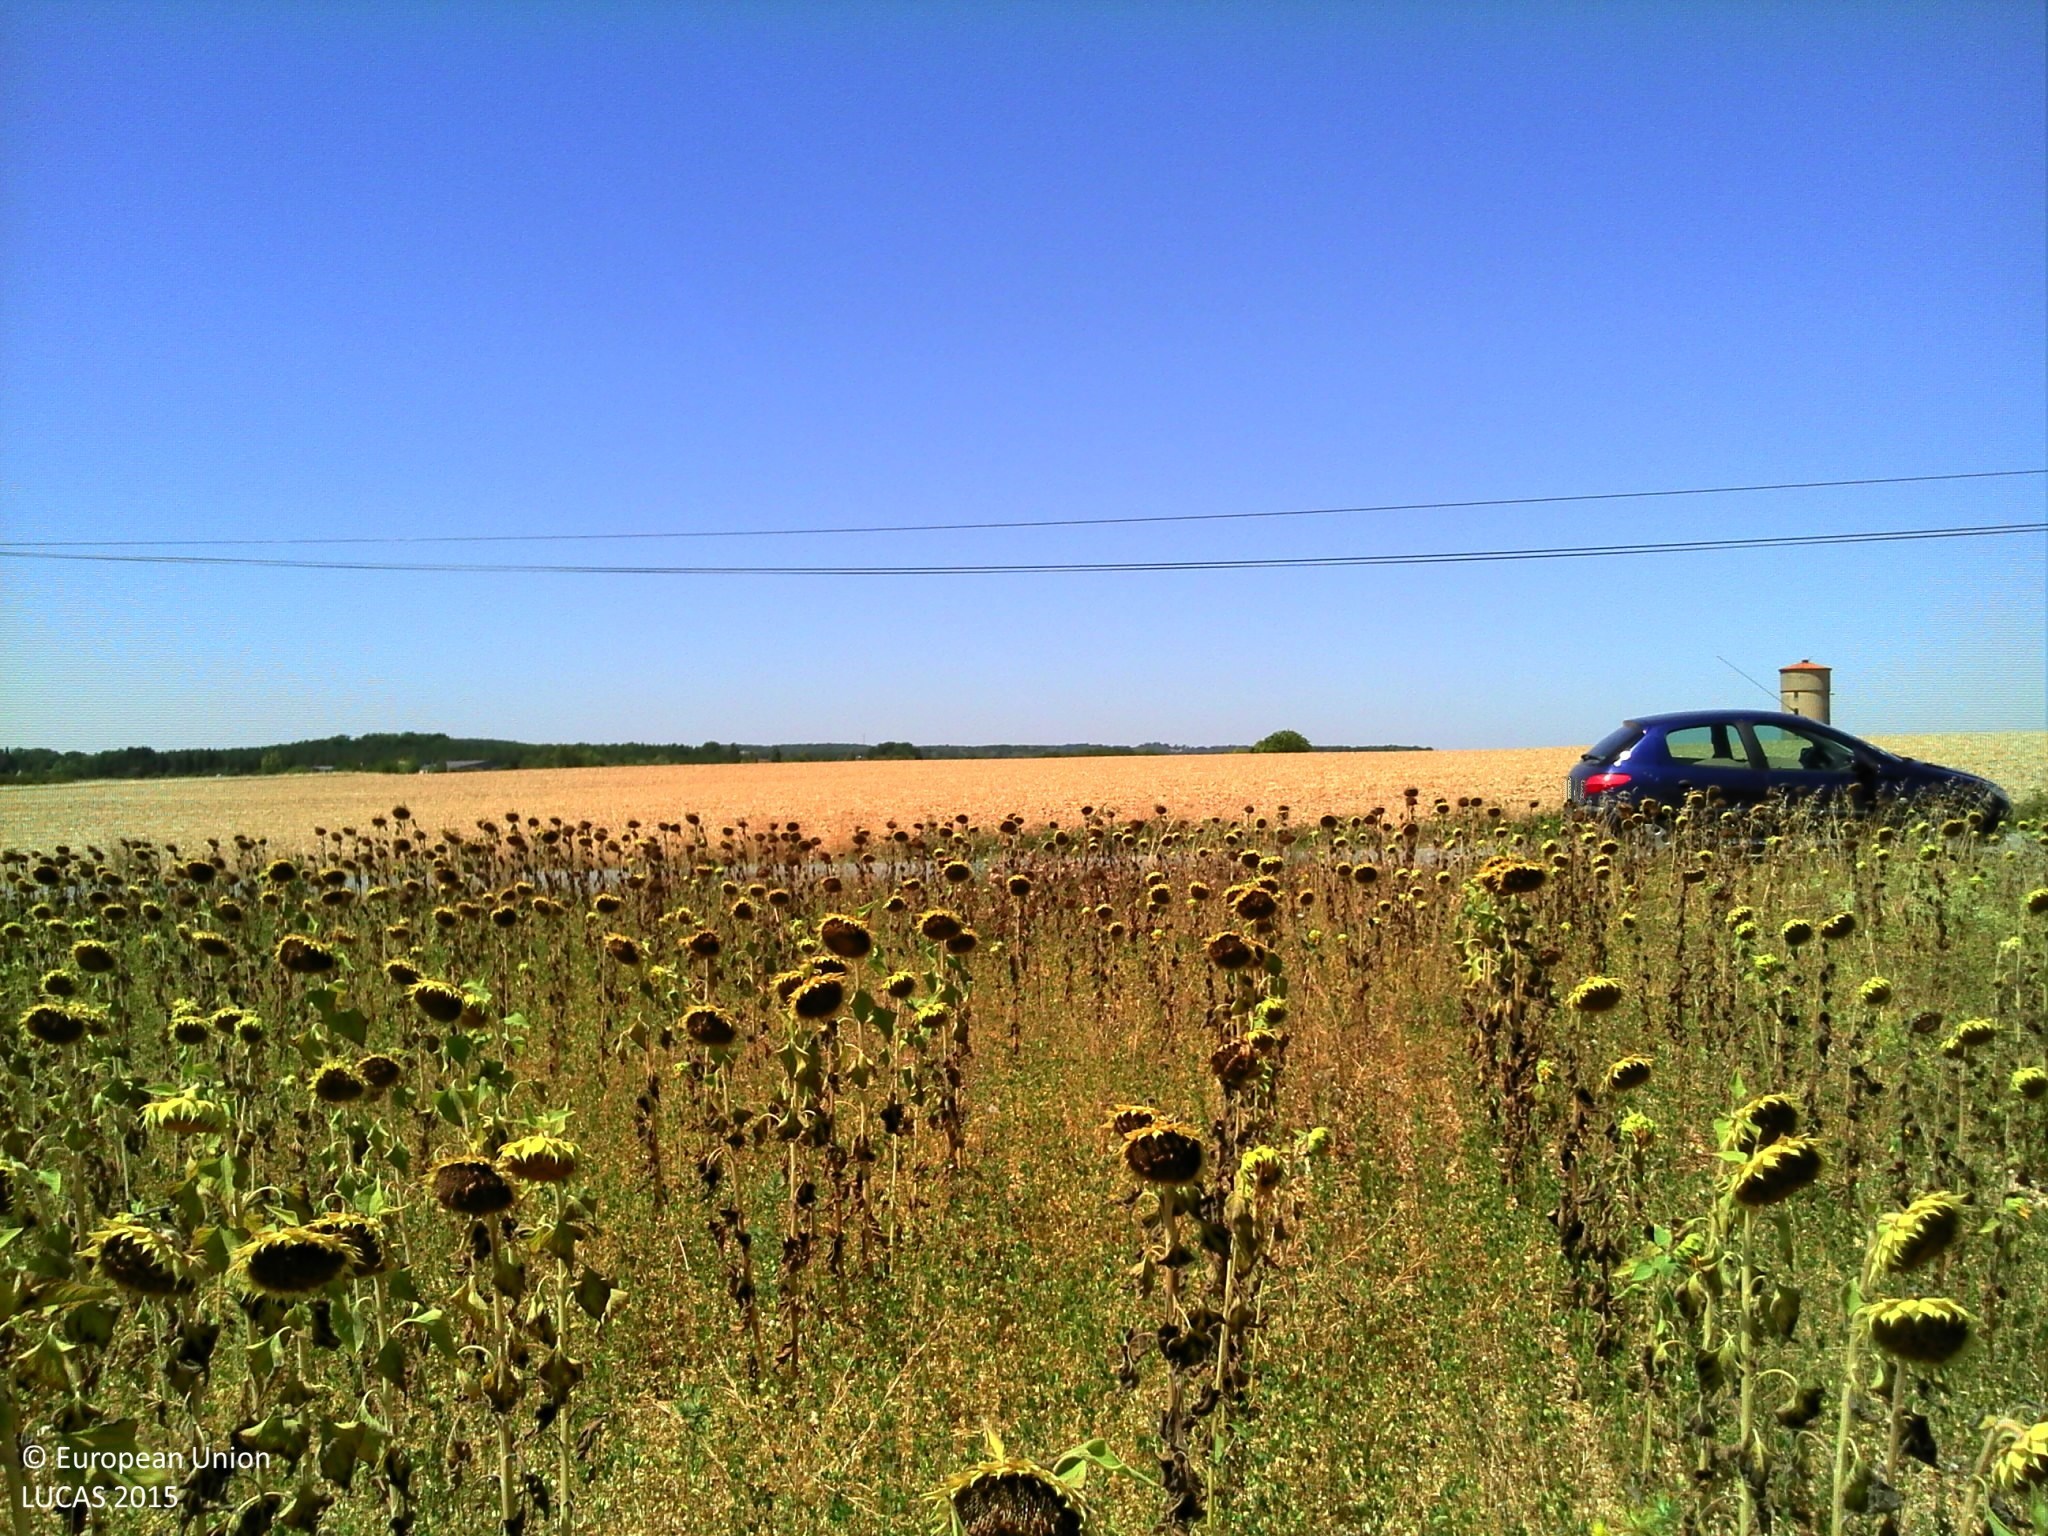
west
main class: Cropland
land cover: Sunflower
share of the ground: 25 - 50 %
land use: Agriculture (excluding fallow land and kitchen gardens)
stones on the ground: > 50 %
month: August
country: FR
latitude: 44.7403
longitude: 0.6083
